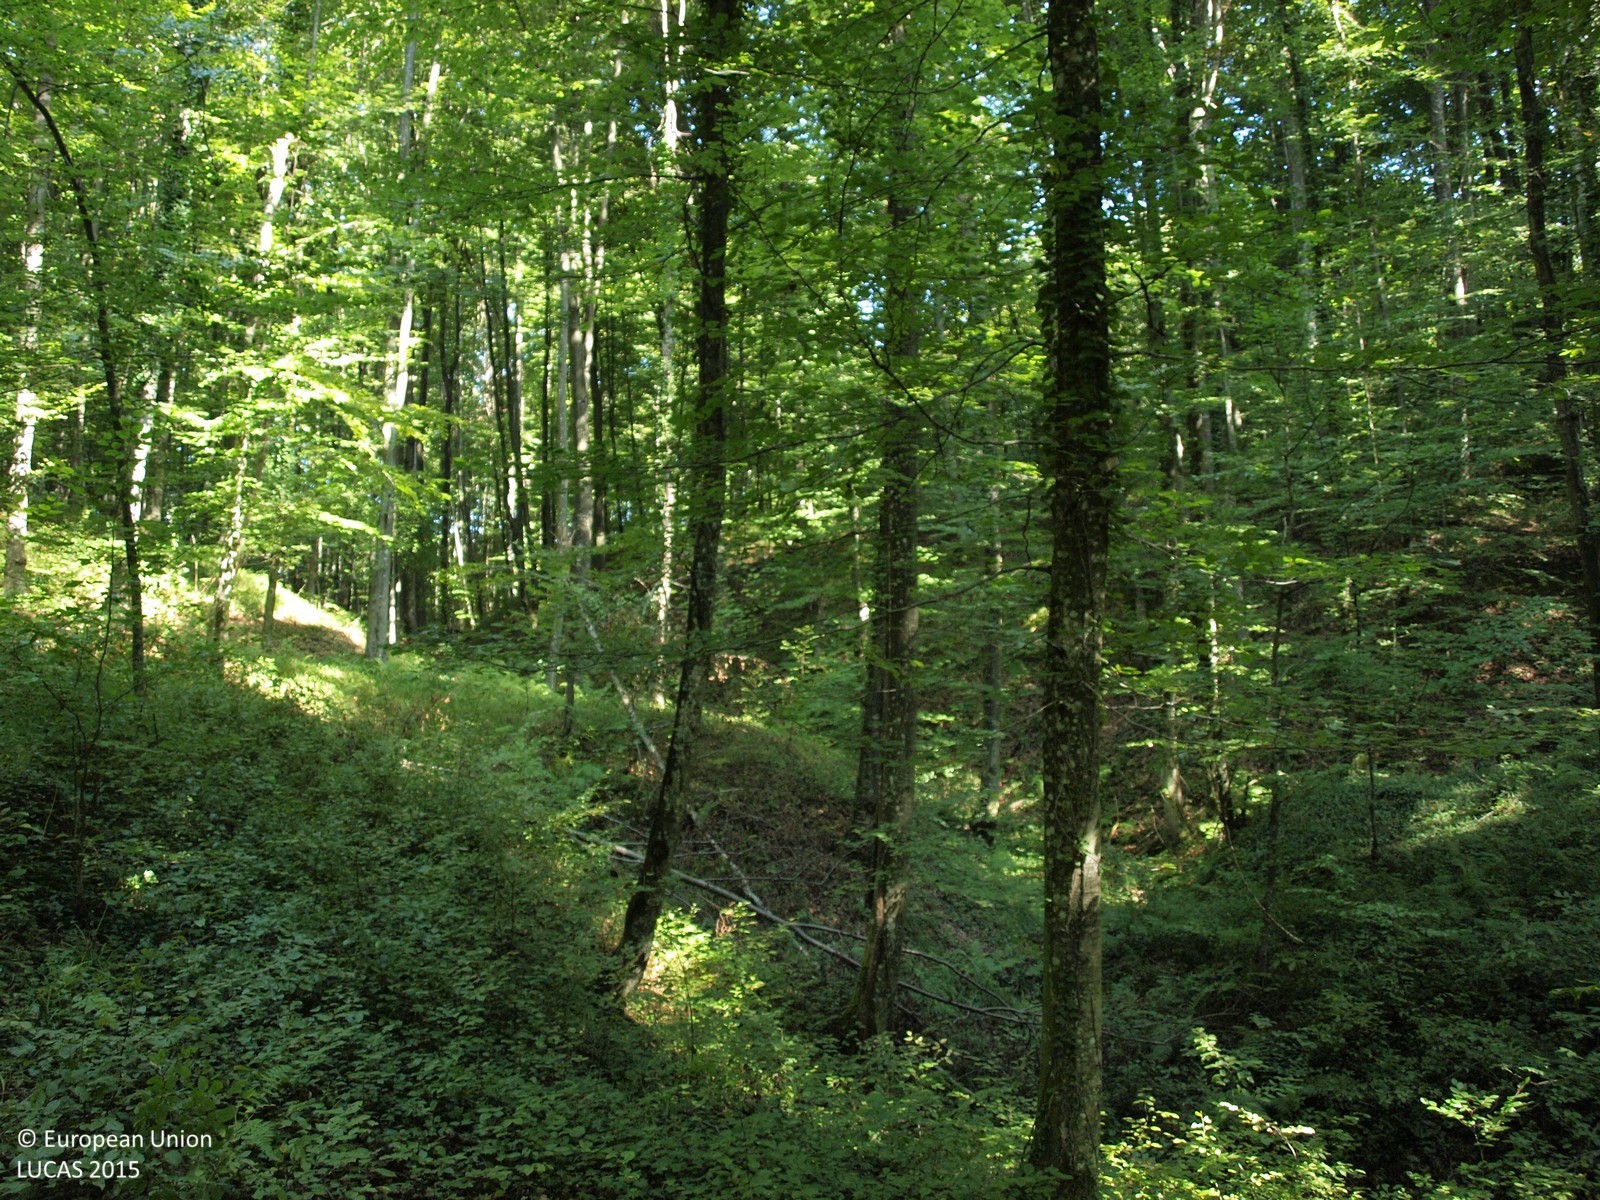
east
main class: Woodland
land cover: Broadleaved woodland
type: mesophytic deciduous forest
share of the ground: > 75 %
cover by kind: broadleaved forest trees 100 %
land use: Forestry
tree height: > 5 m
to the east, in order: Broadleaved woodland
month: September
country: HR
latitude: 45.5488
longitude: 16.0301
